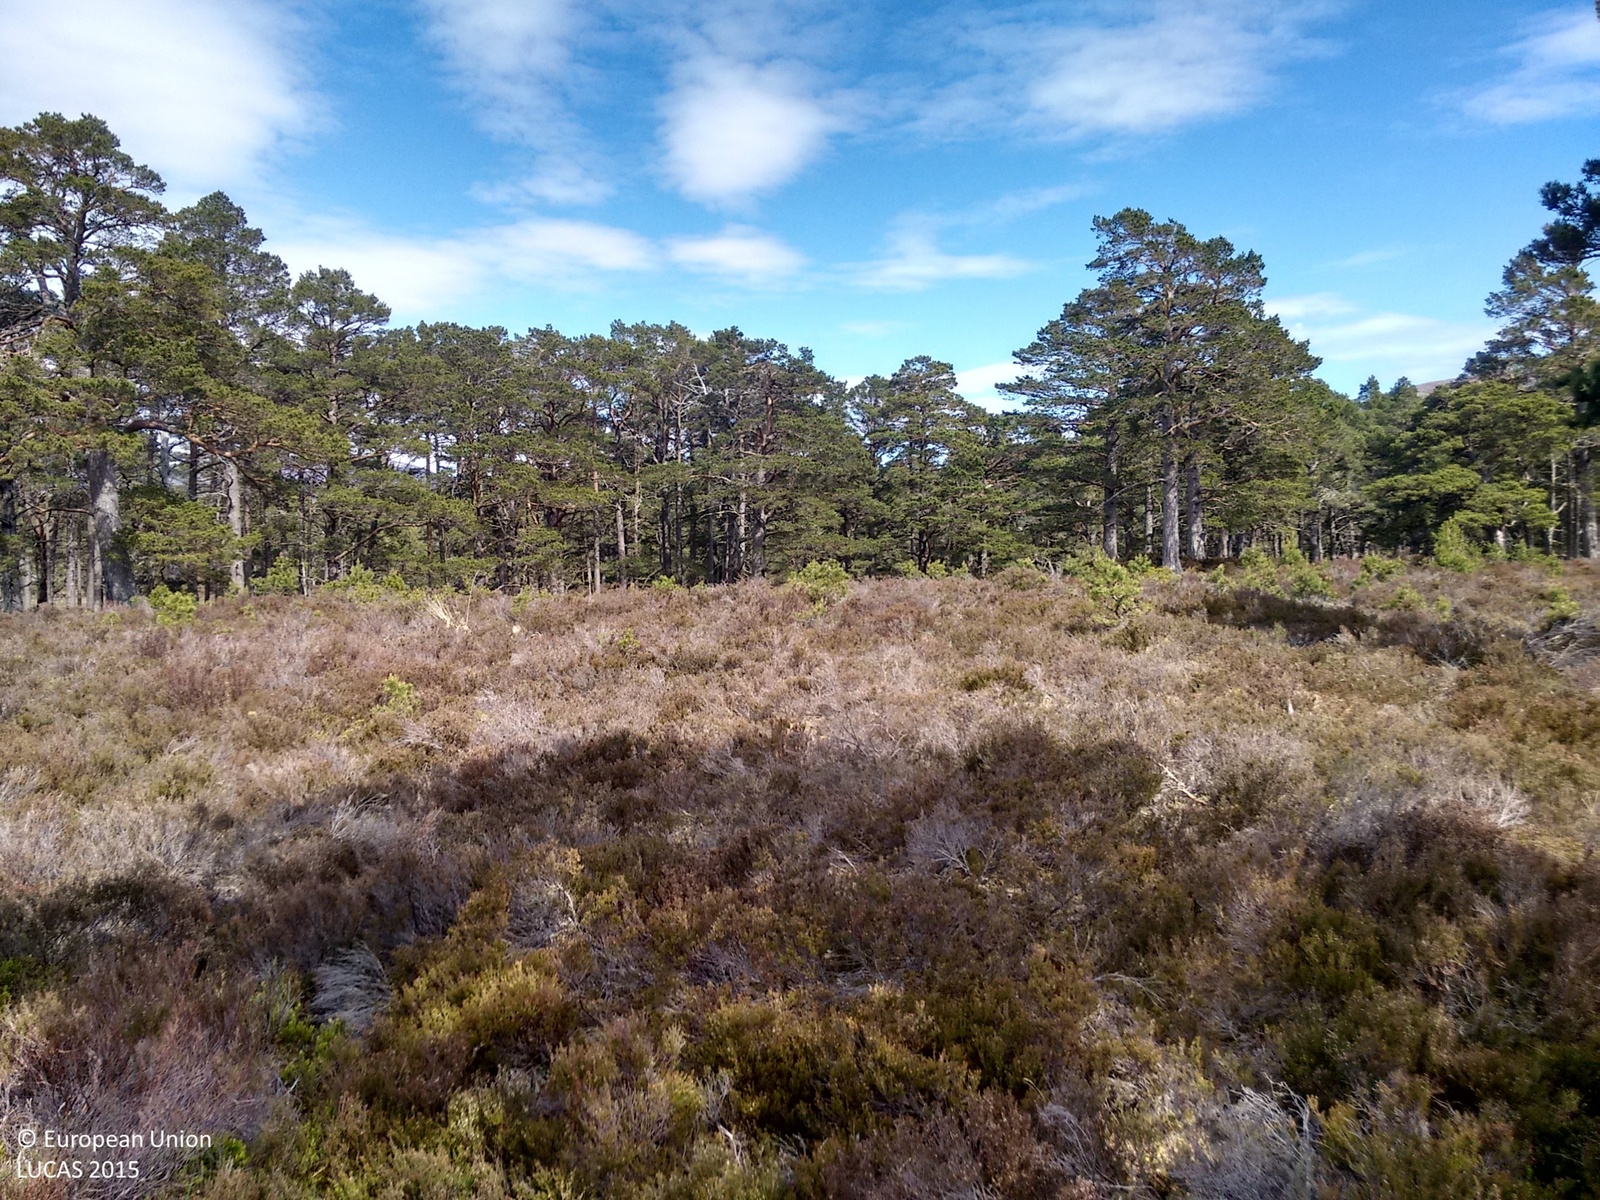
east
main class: Shrubland
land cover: Shrubland without tree cover
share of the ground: > 75 %
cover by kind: shrubs 100 %
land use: Forestry
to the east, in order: Shrubland without tree cover; Pine dominated coniferous woodland; Shrubland with sparse tree cover; Tracks; Pine dominated coniferous woodland; Shrubland without tree cover; Pine dominated coniferous woodland; Shrubland without tree cover; Pine dominated coniferous woodland; Shrubland without tree cover; Pine dominated coniferous woodland
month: June
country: GB
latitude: 57.1396
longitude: -3.7765
